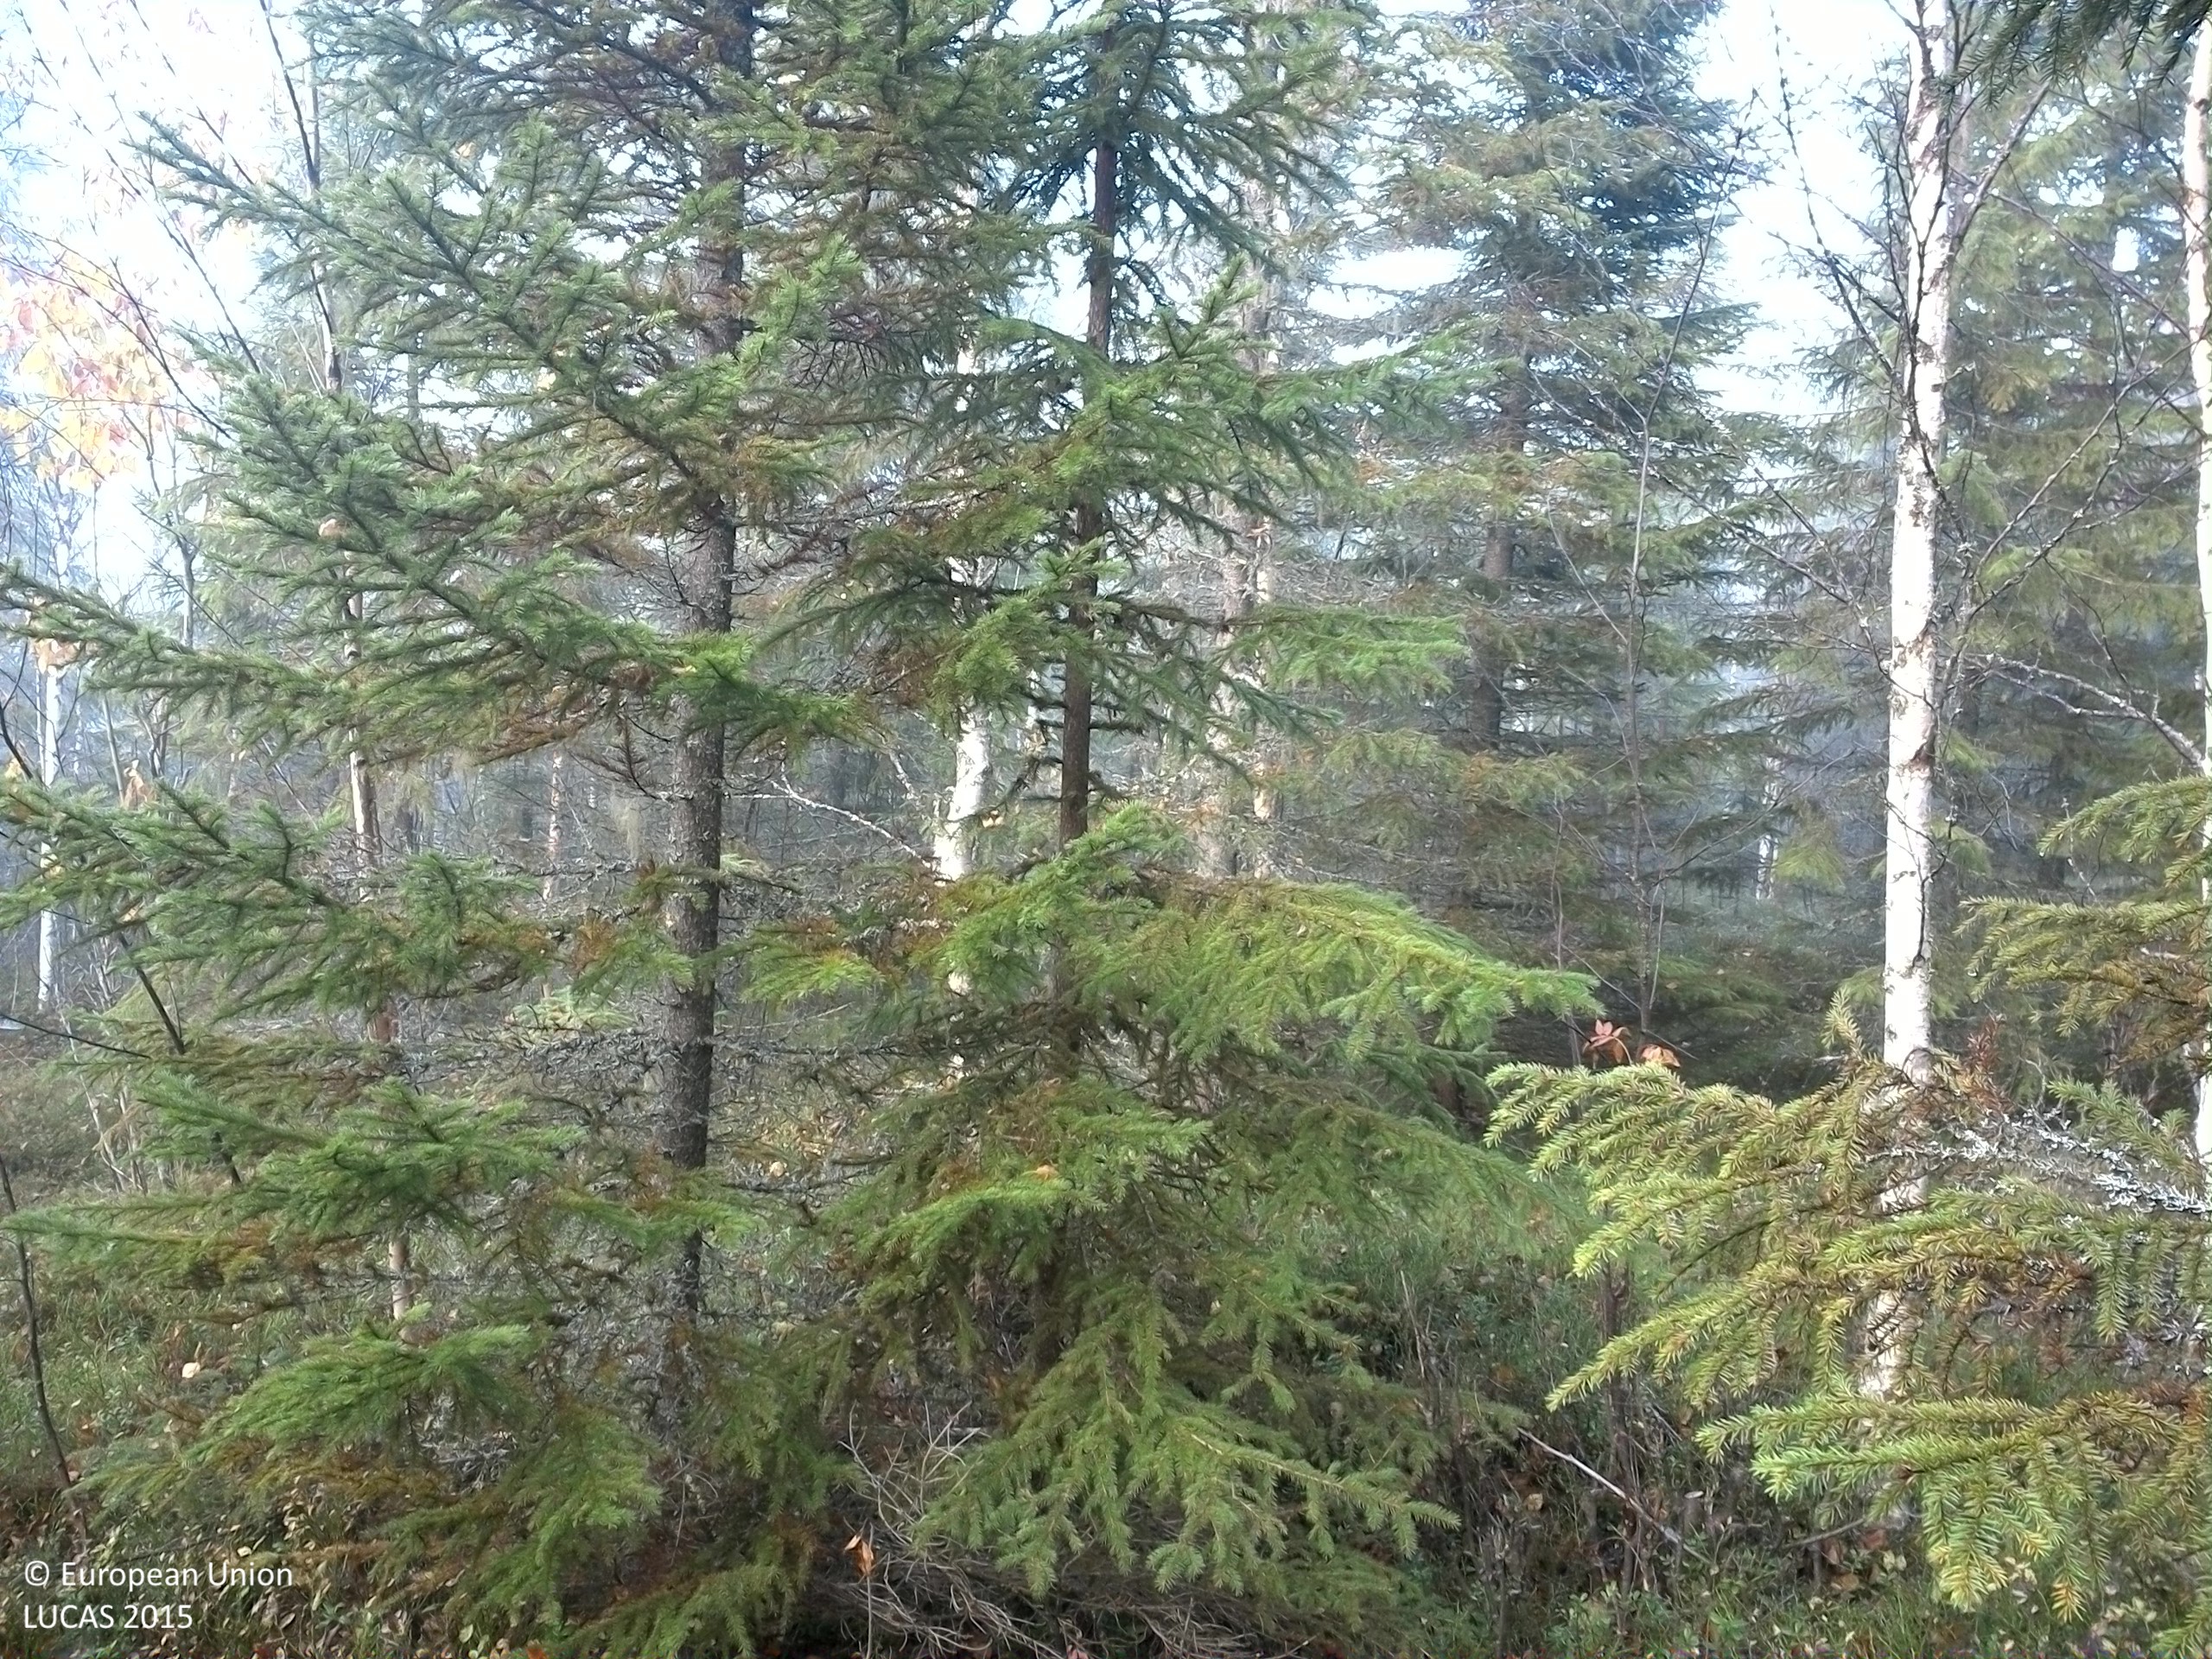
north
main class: Woodland
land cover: Spruce dominated coniferous woodland
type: boreal forest
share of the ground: 50 - 75 %
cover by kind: coniferous forest trees 50 %, shrubs 25 %, broadleaved forest trees 15 %, lichens and mosses 10 %
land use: Forestry
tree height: > 5 m
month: October
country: SE
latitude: 64.0556
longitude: 16.3011
